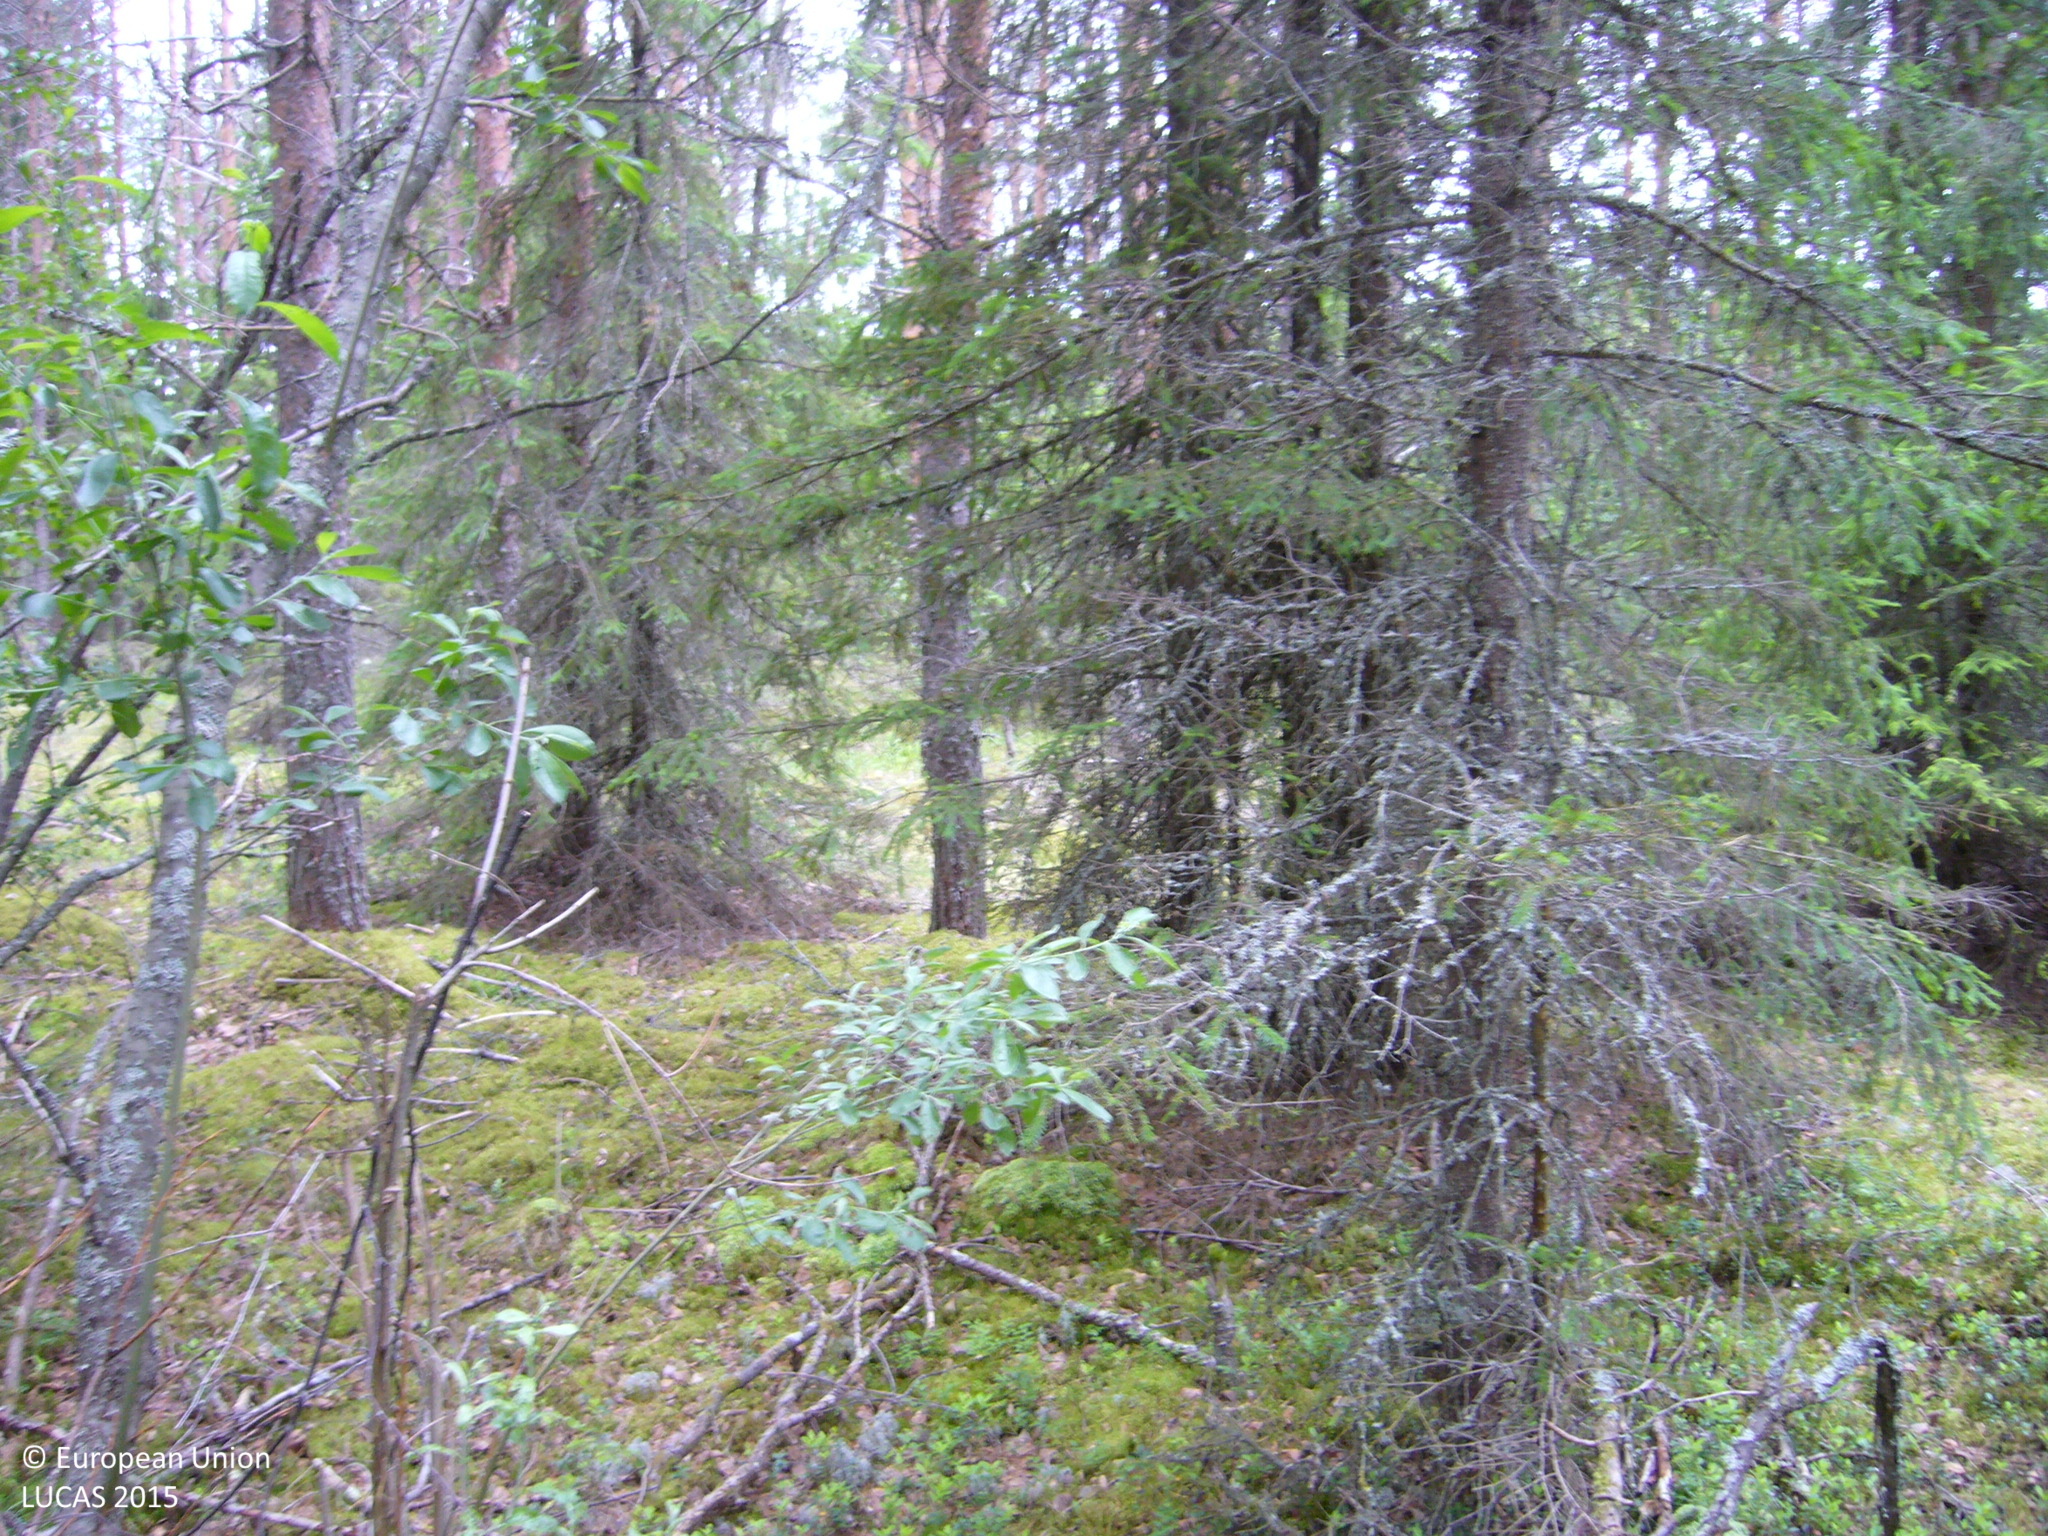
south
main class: Woodland
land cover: Other mixed woodland
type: boreal forest
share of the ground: > 75 %
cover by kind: coniferous forest trees 40 %, broadleaved forest trees 35 %, shrubs 25 %
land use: Forestry
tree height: > 5 m
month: July
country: FI
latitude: 63.2694
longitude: 26.1209
